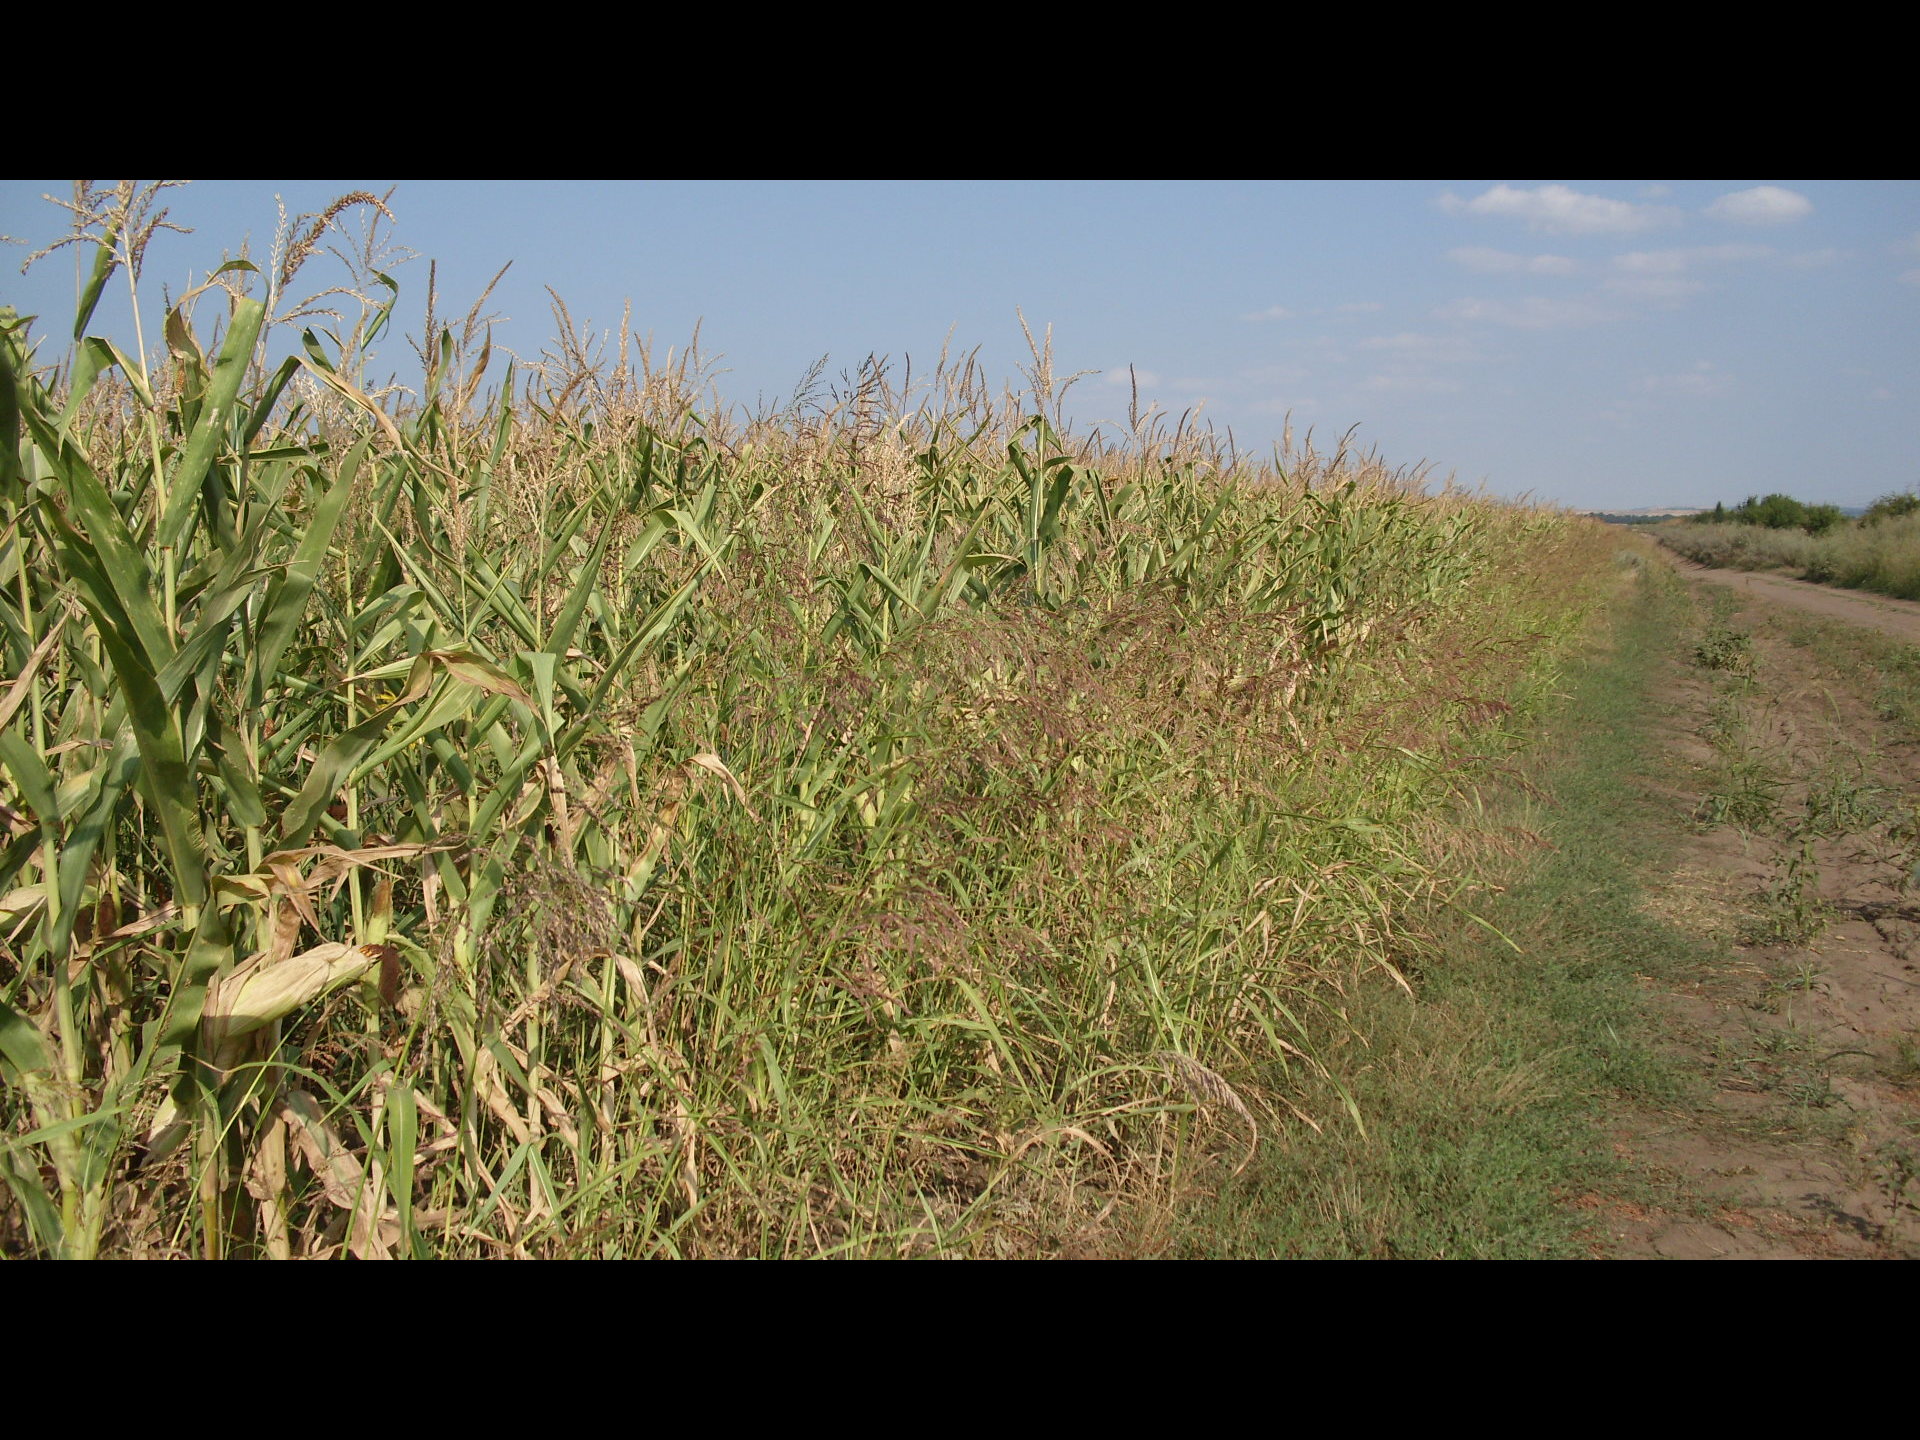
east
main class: Cropland
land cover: Maize
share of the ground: > 75 %
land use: Agriculture (excluding fallow land and kitchen gardens)
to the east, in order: Maize
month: August
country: BG
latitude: 43.6738
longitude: 23.7053
